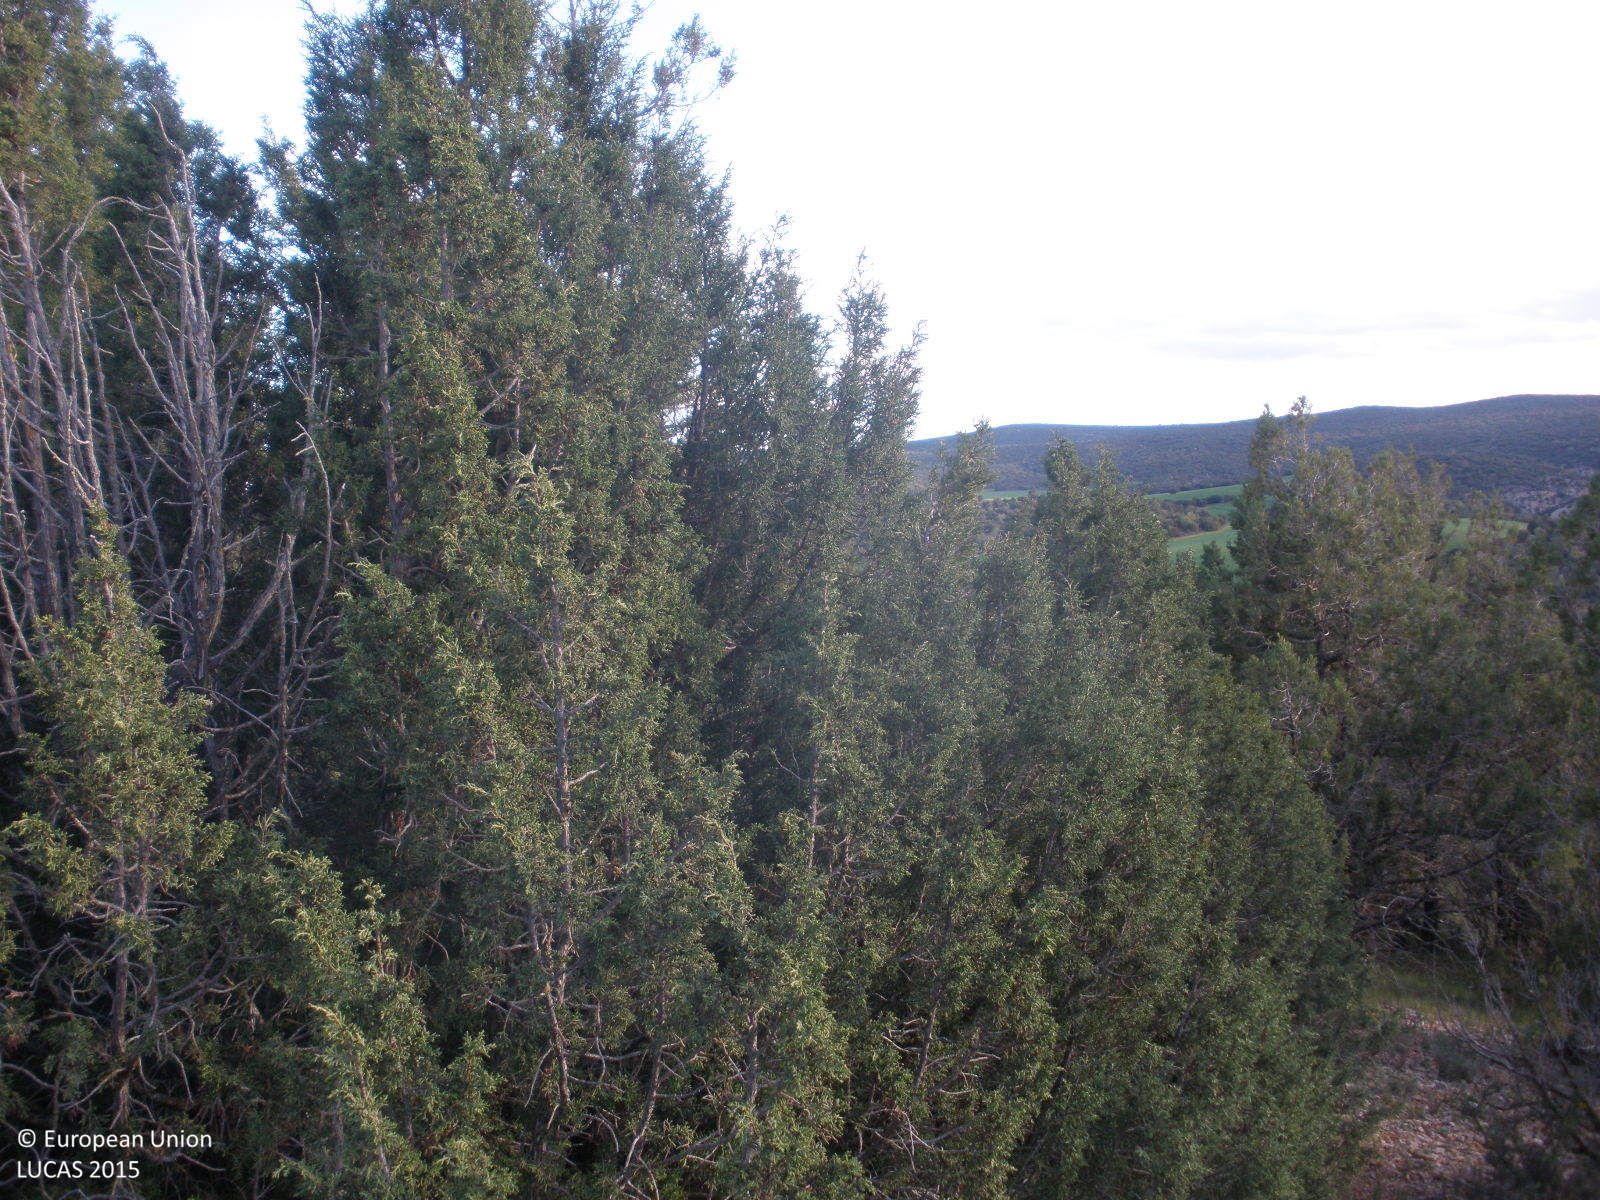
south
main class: Woodland
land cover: Other coniferous woodland
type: coniferous forest of the mediterranean region
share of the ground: 50 - 75 %
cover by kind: coniferous forest trees 60 %, consolidated bare surface 30 %, shrubs 10 %
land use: Semi-natural and natural areas not in use
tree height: < 5 m
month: April
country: ES
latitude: 40.3832
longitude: -1.2614
